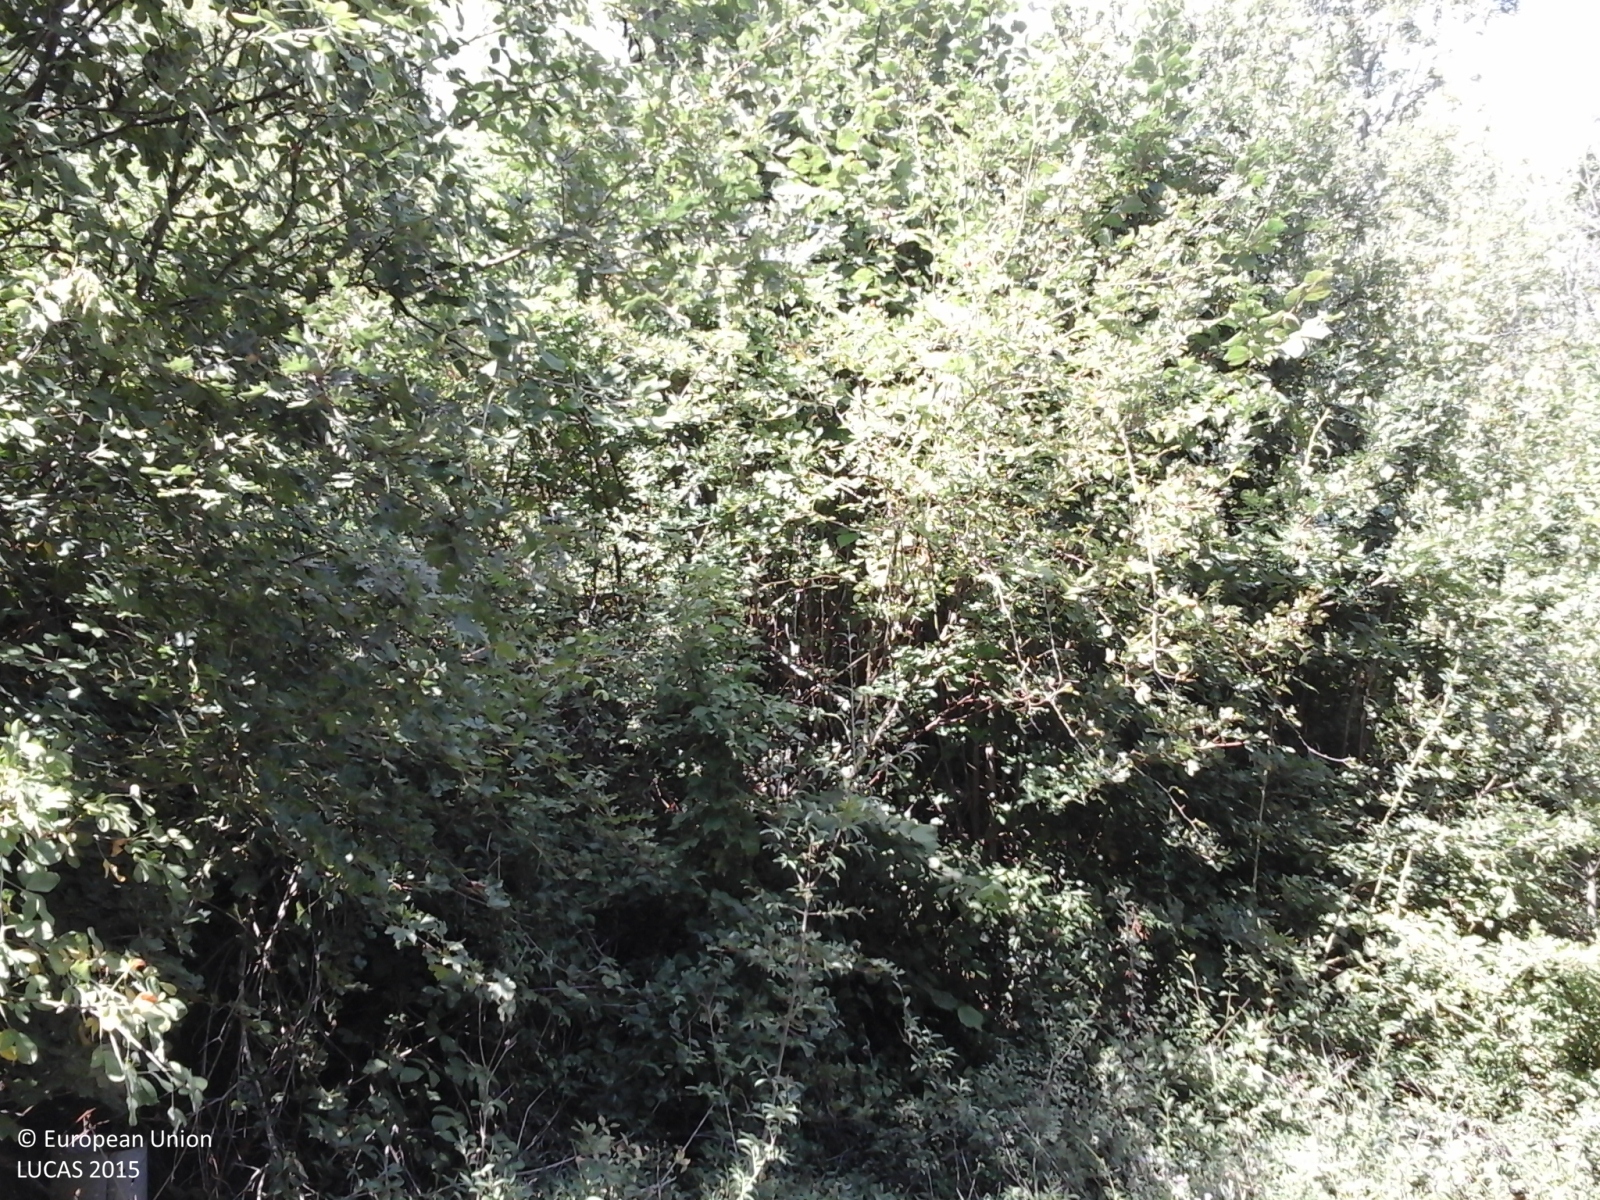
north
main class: Woodland
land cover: Broadleaved woodland
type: thermophilous deciduous forest
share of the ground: > 75 %
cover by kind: broadleaved forest trees 95 %, shrubs 5 %
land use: Forestry
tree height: > 5 m
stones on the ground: < 10 %
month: August
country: IT
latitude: 41.7356
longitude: 14.1815
